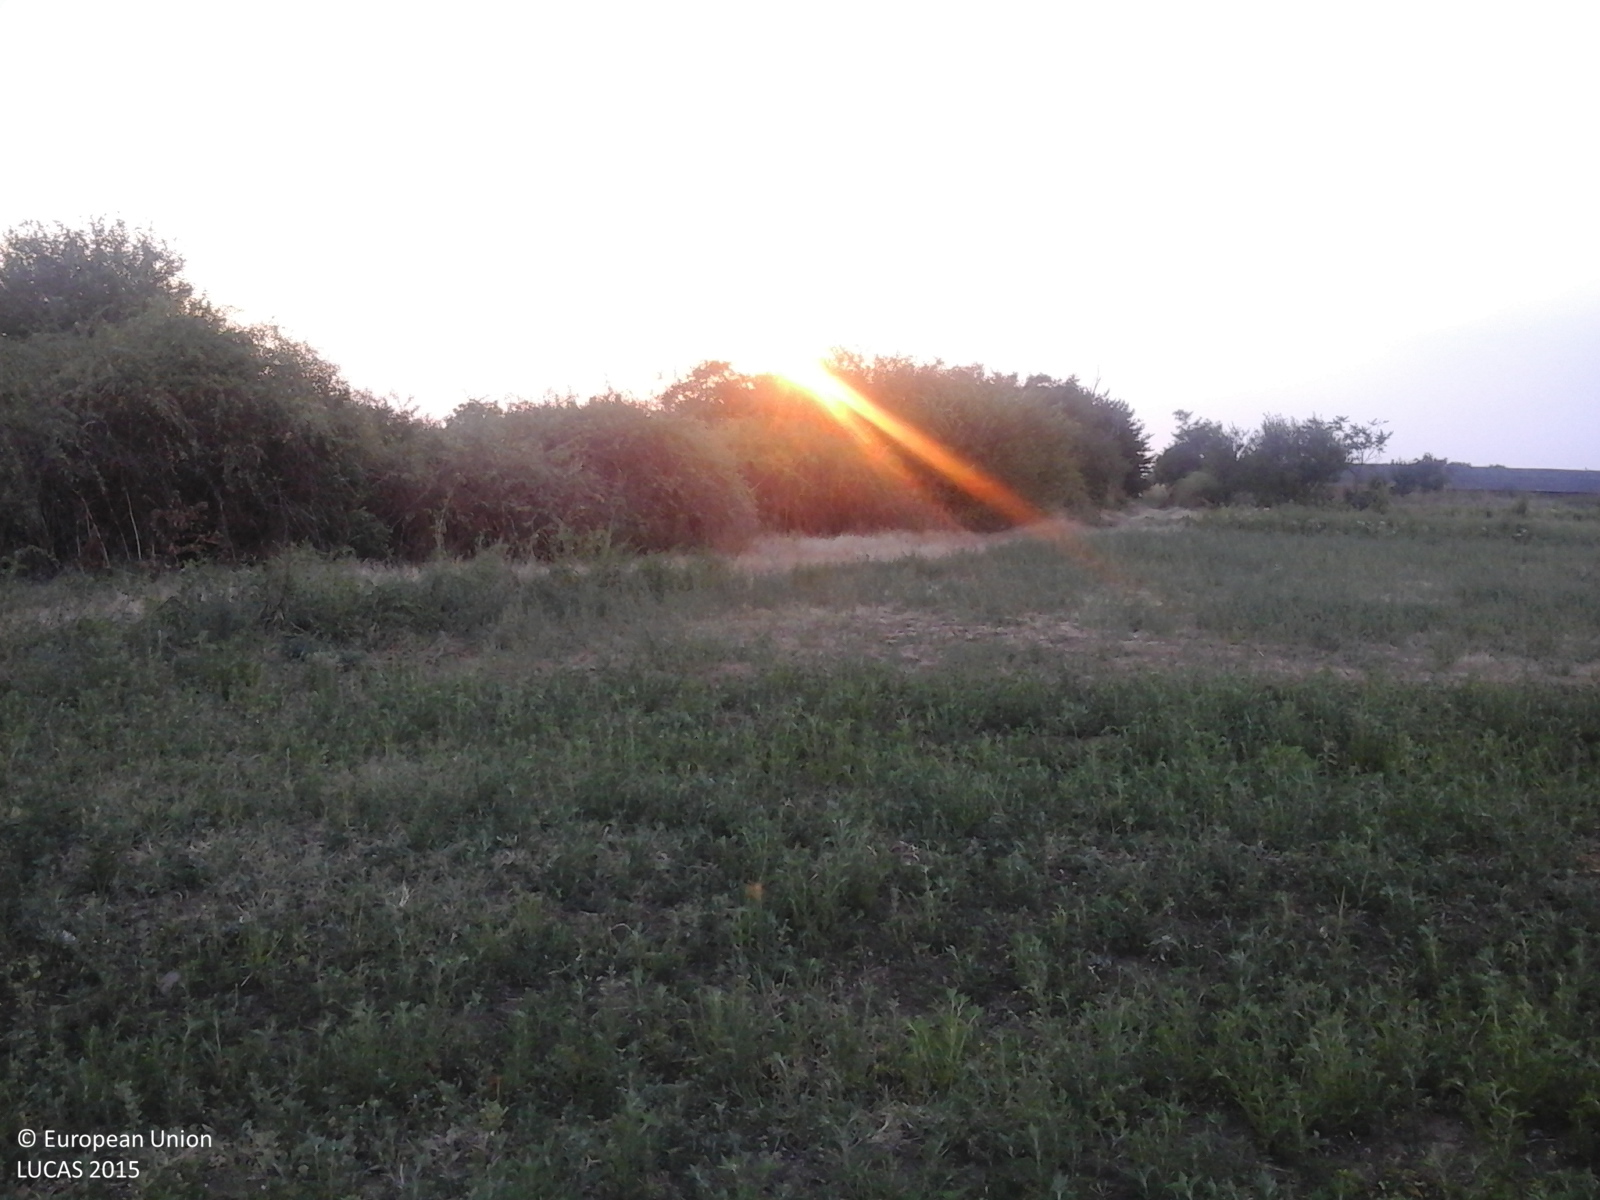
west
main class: Cropland
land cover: Lucerne
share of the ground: > 75 %
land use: Agriculture (excluding fallow land and kitchen gardens)
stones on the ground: < 10 %
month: August
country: RO
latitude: 44.3194
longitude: 23.0979
